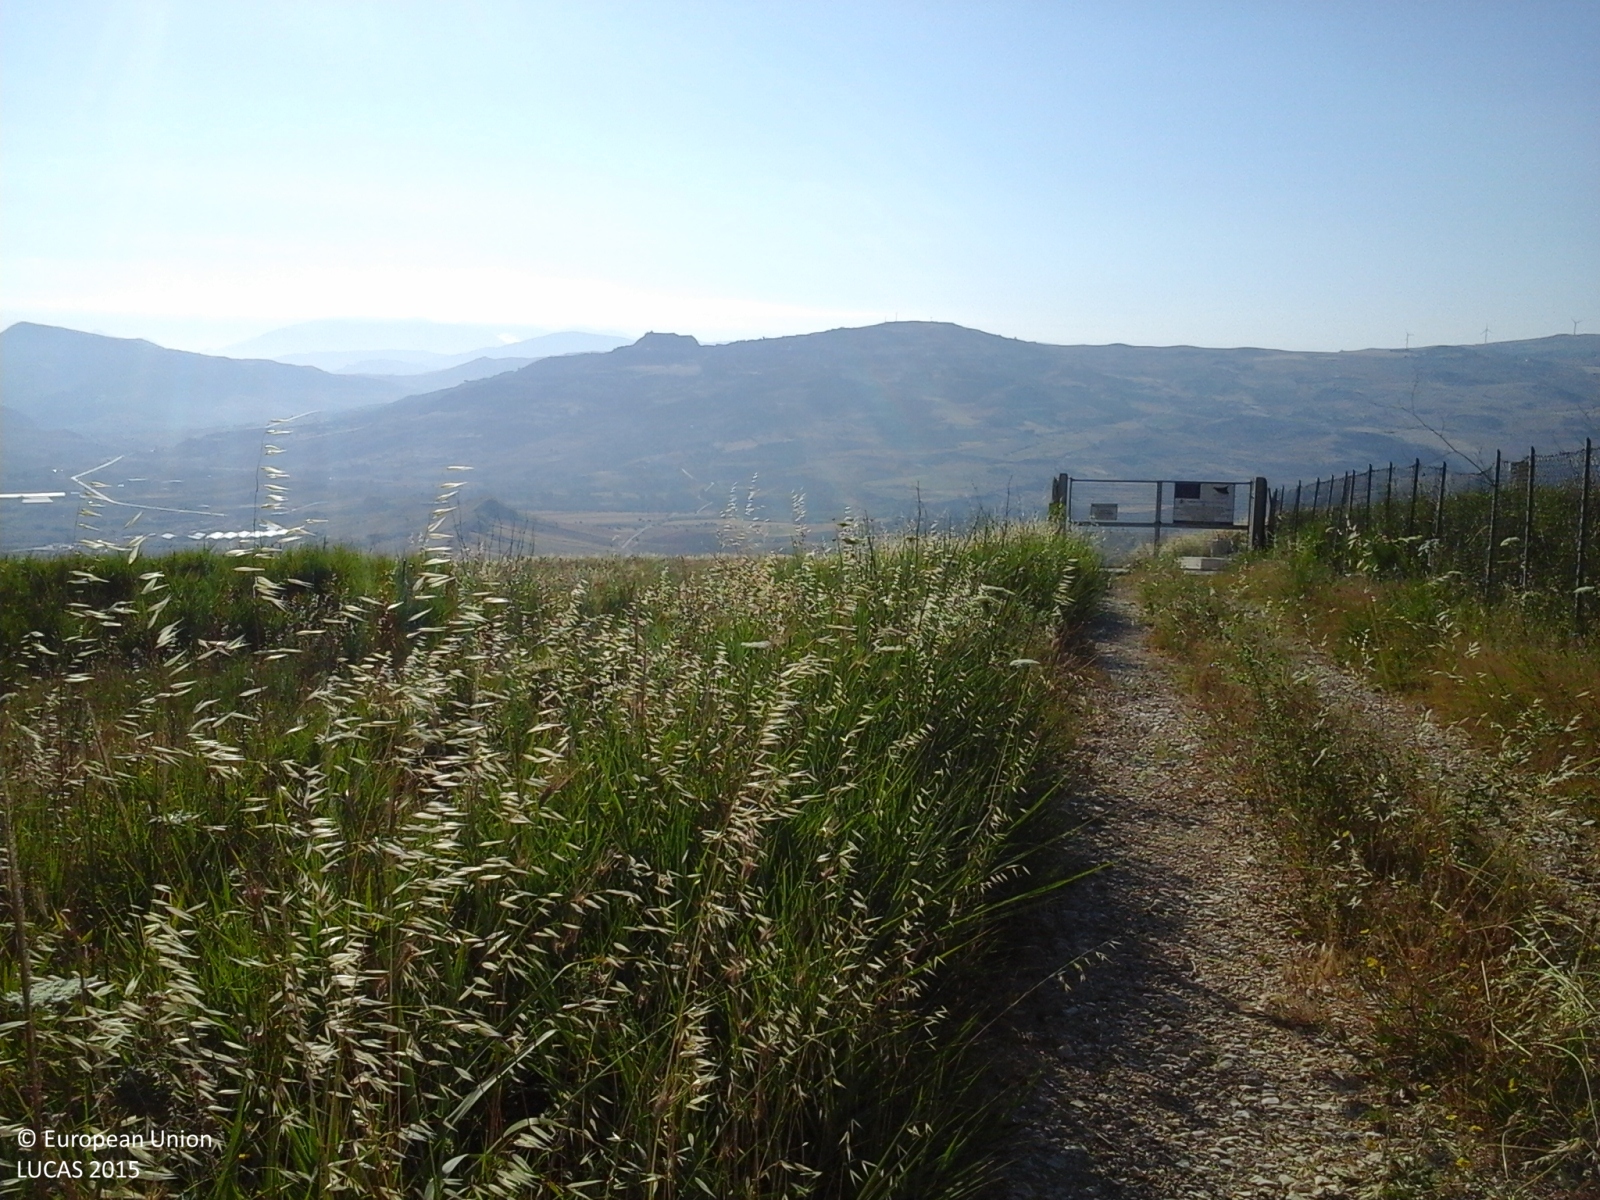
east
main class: Grassland
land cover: Grassland with sparse tree/shrub cover
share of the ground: > 75 %
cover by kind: herbaceous plants 85 %, shrubs 10 %, broadleaved forest trees 5 %
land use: Agriculture (excluding fallow land and kitchen gardens)
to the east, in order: Grassland with sparse tree/shrub cover; Artificial constructions in urban areas; Grass margins; Durum wheat
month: June
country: IT
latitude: 37.8282
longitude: 13.5080
